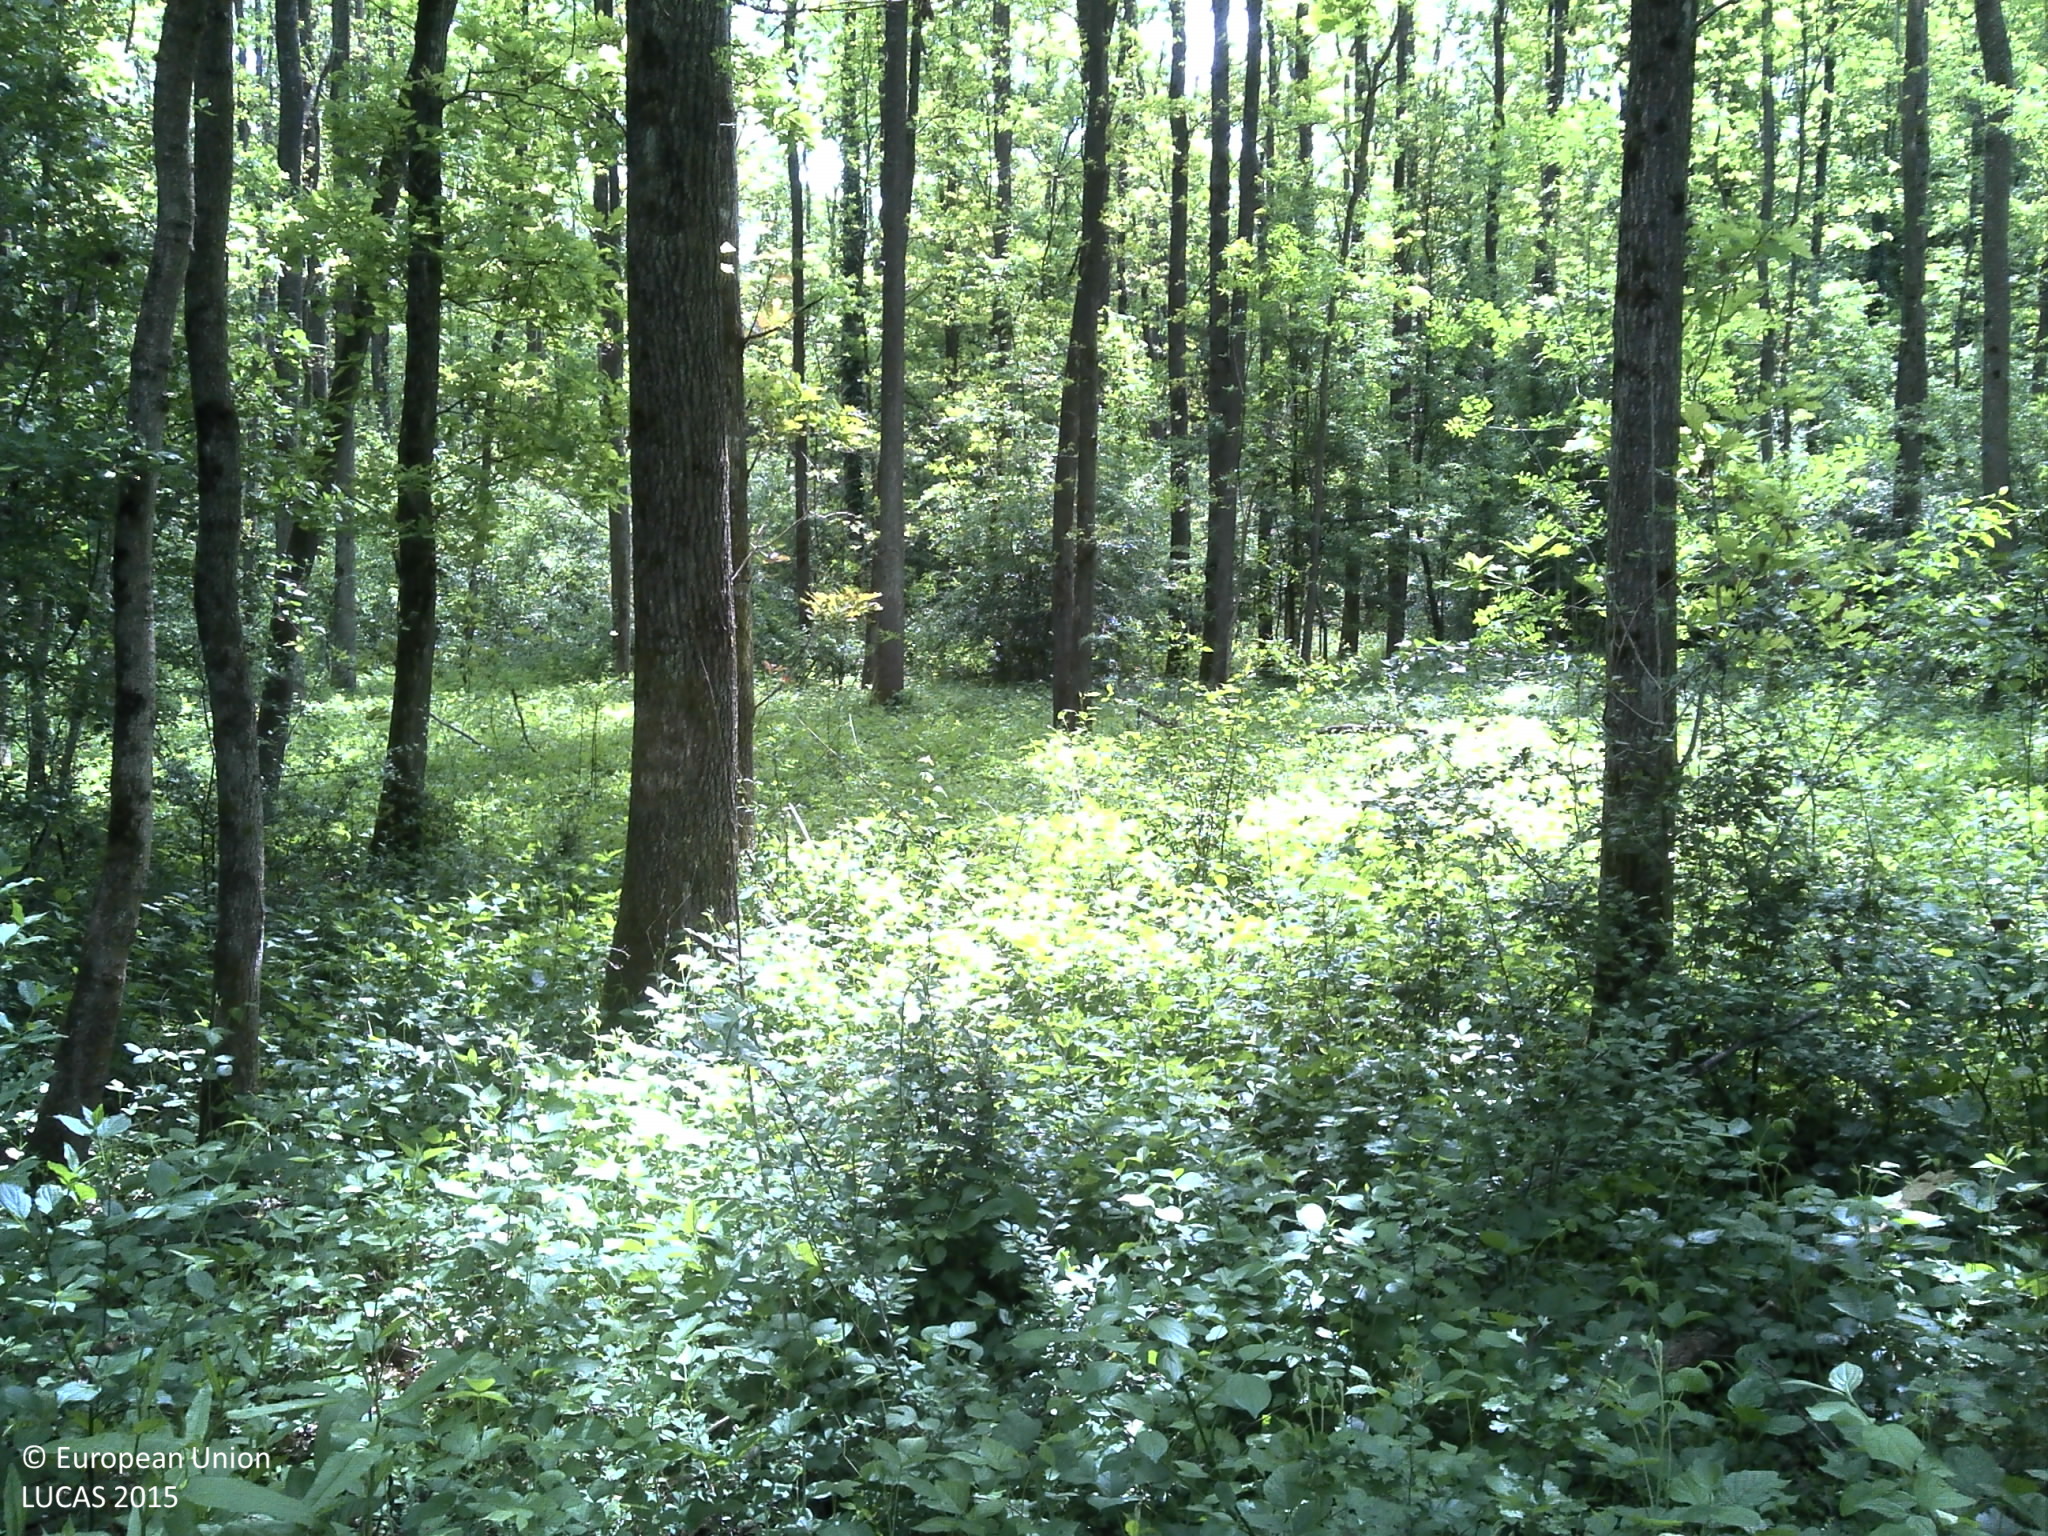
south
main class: Woodland
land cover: Broadleaved woodland
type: acidophilous oak and oak-birch forest
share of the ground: > 75 %
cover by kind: broadleaved forest trees 100 %
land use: Forestry
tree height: > 5 m
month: May
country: HR
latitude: 45.1158
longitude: 18.6110
